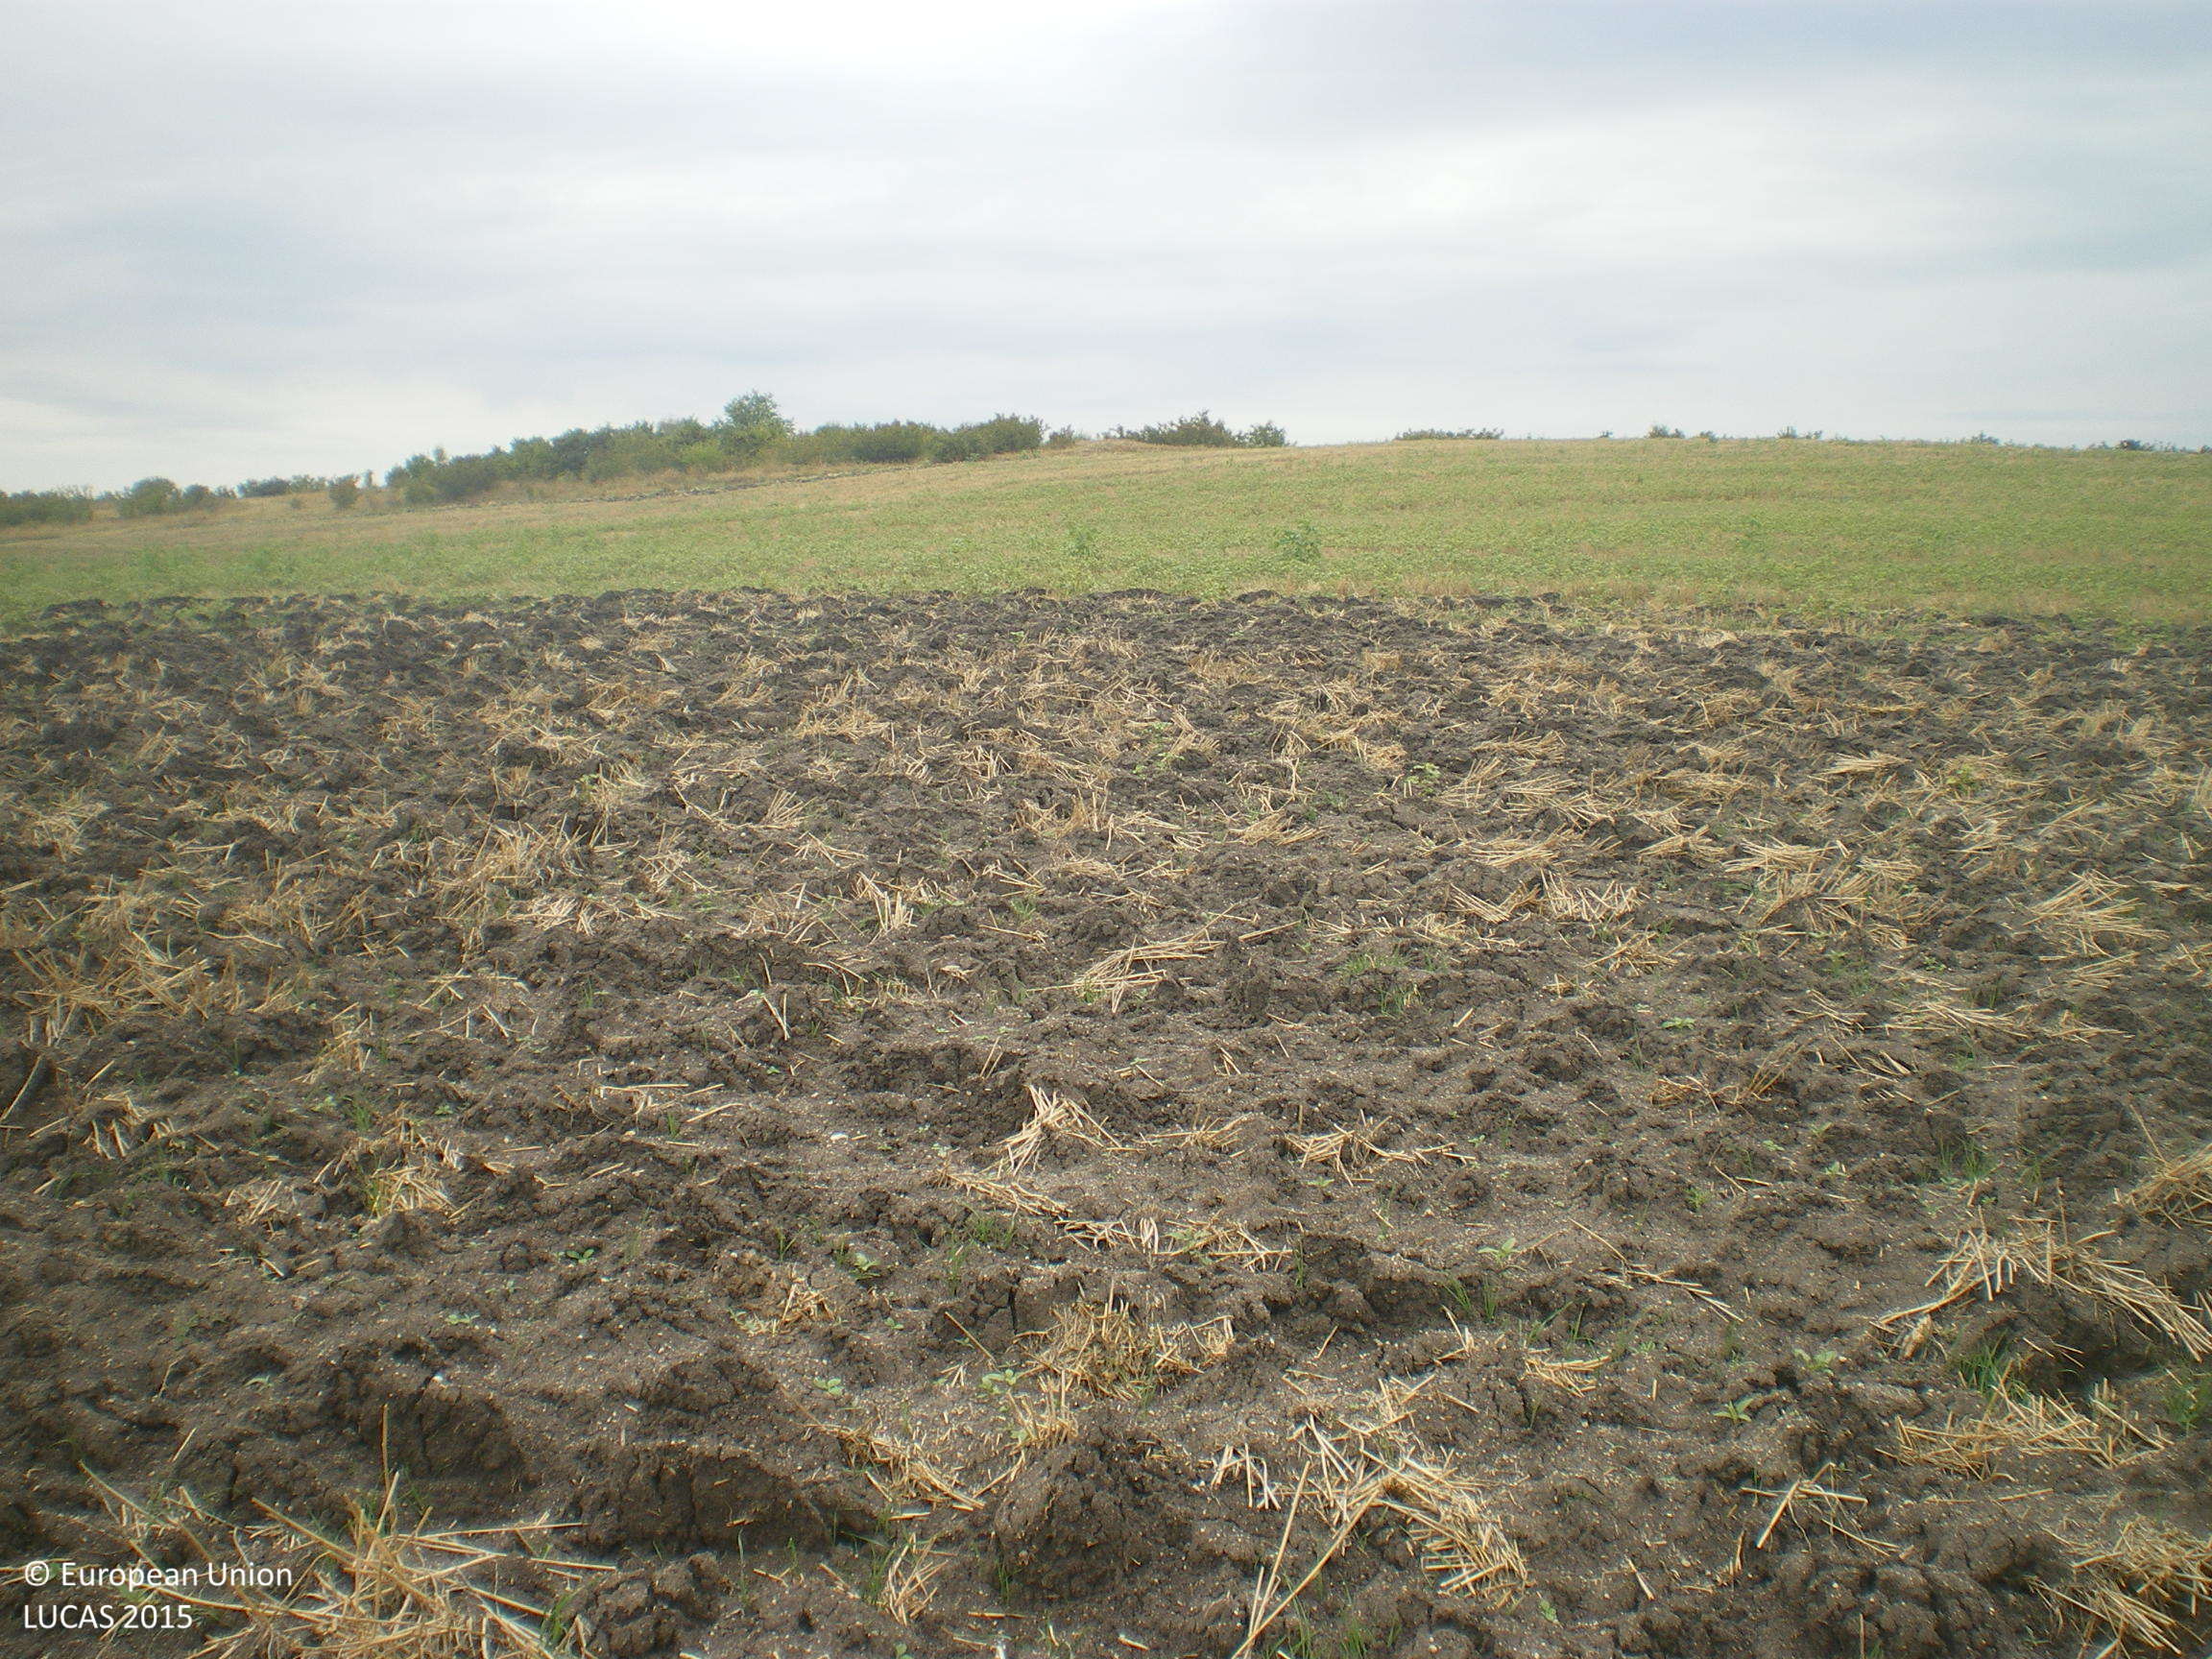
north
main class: Cropland
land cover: Common wheat
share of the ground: < 10 %
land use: Agriculture (excluding fallow land and kitchen gardens)
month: September
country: BG
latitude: 42.2041
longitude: 25.8553
